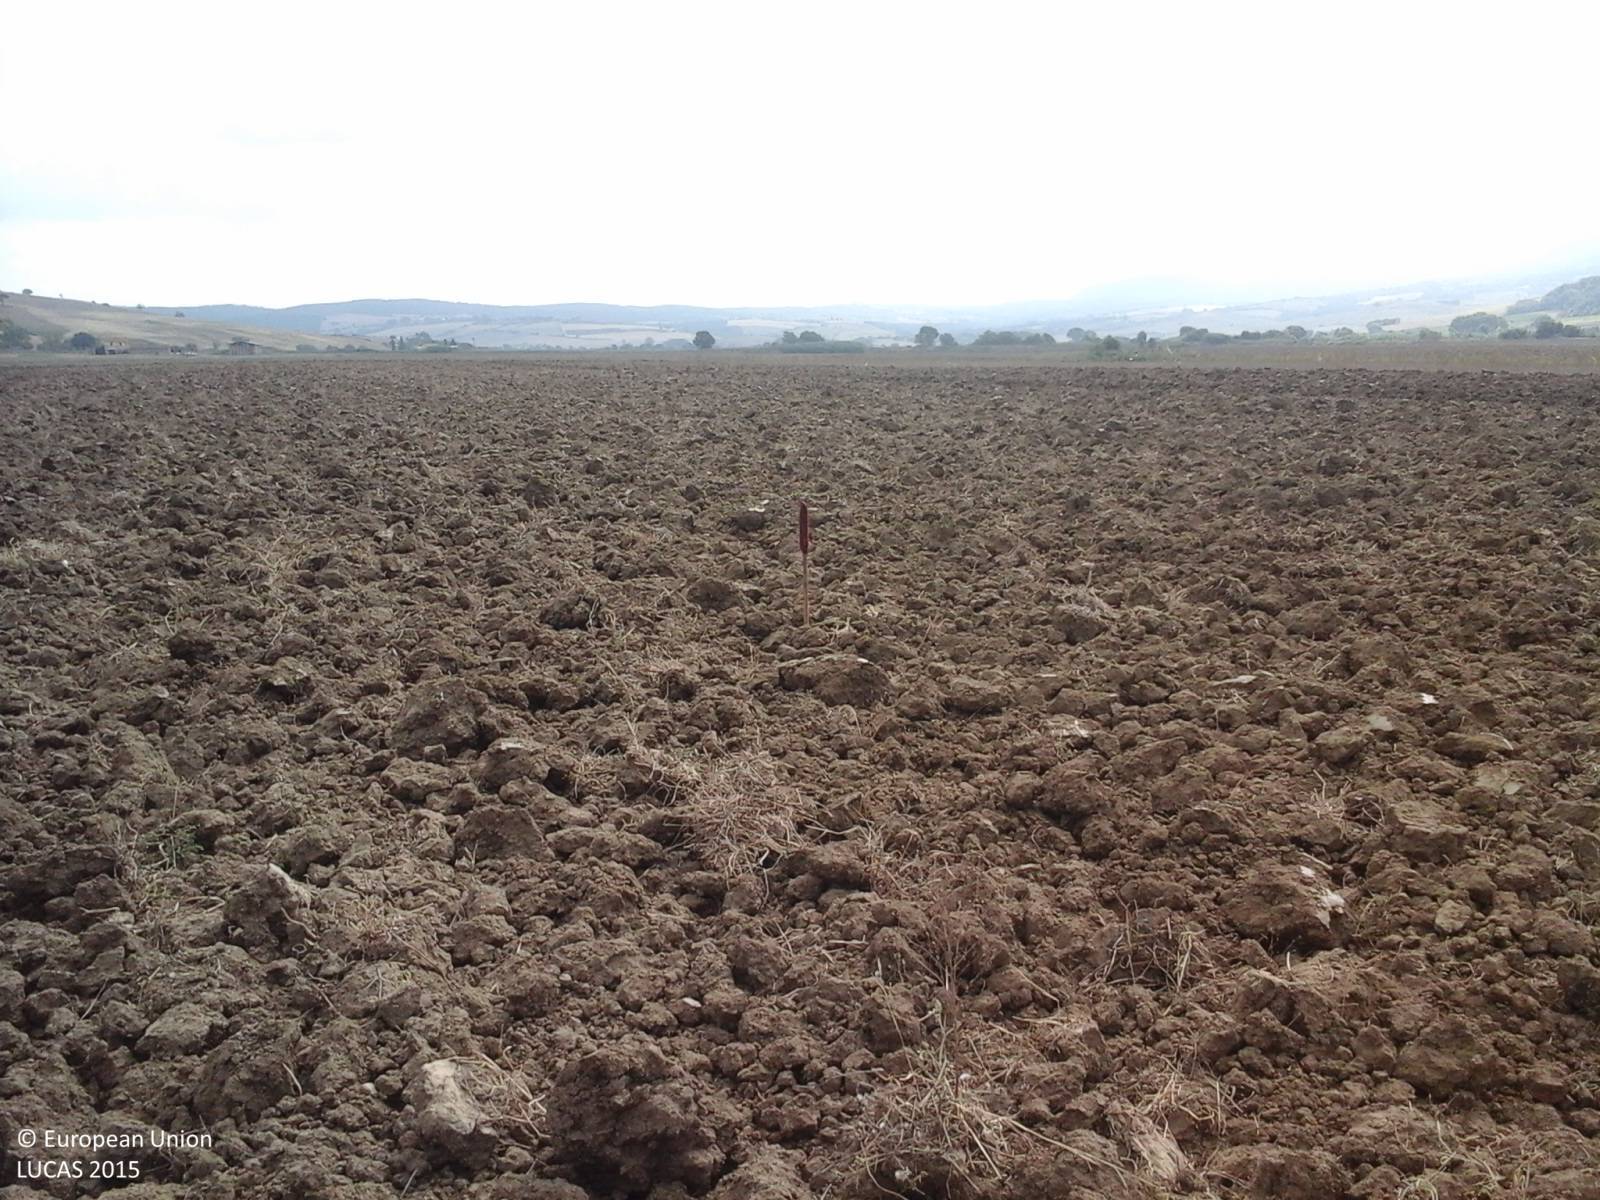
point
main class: Grassland
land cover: Spontaneously vegetated surfaces
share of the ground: < 10 %
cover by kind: unconsolidated bare surface 90 %, herbaceous plants 10 %
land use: Agriculture (excluding fallow land and kitchen gardens)
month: August
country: IT
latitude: 42.2216
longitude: 11.8469
